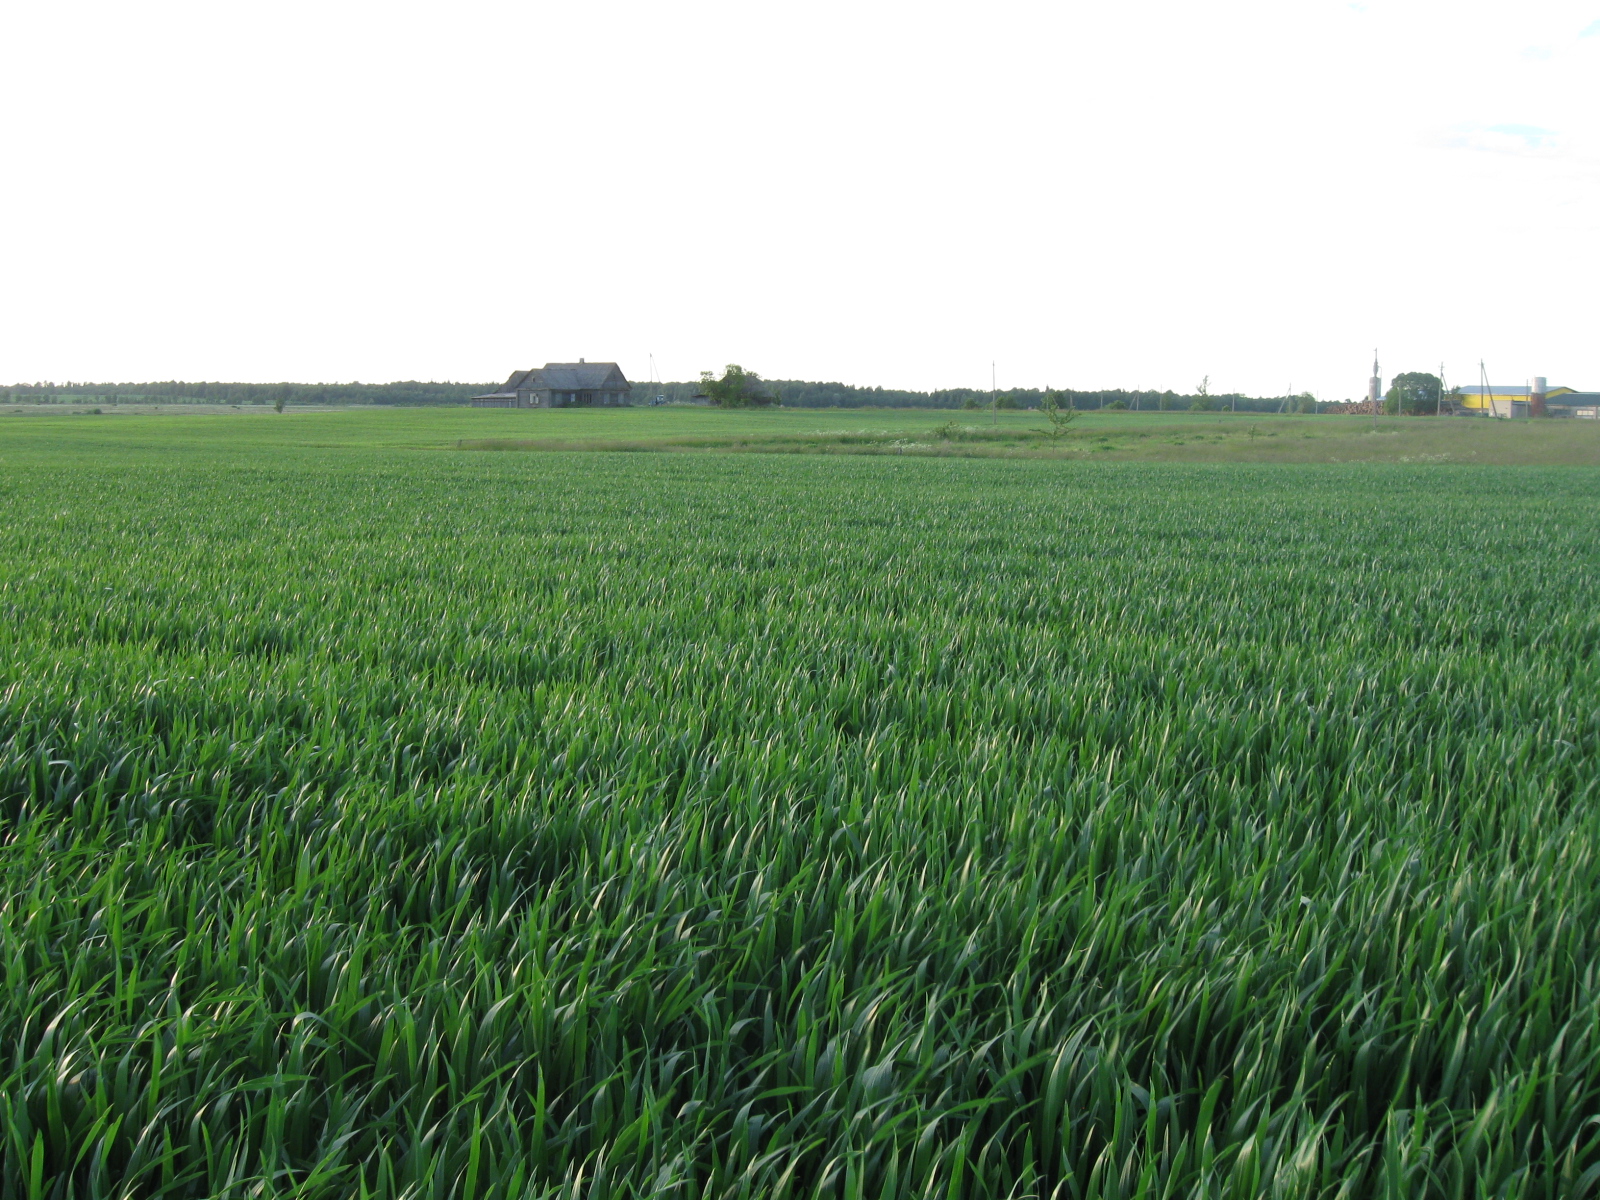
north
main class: Cropland
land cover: Common wheat
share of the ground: > 75 %
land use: Agriculture (excluding fallow land and kitchen gardens)
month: June
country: LT
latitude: 55.0384
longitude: 24.0977
